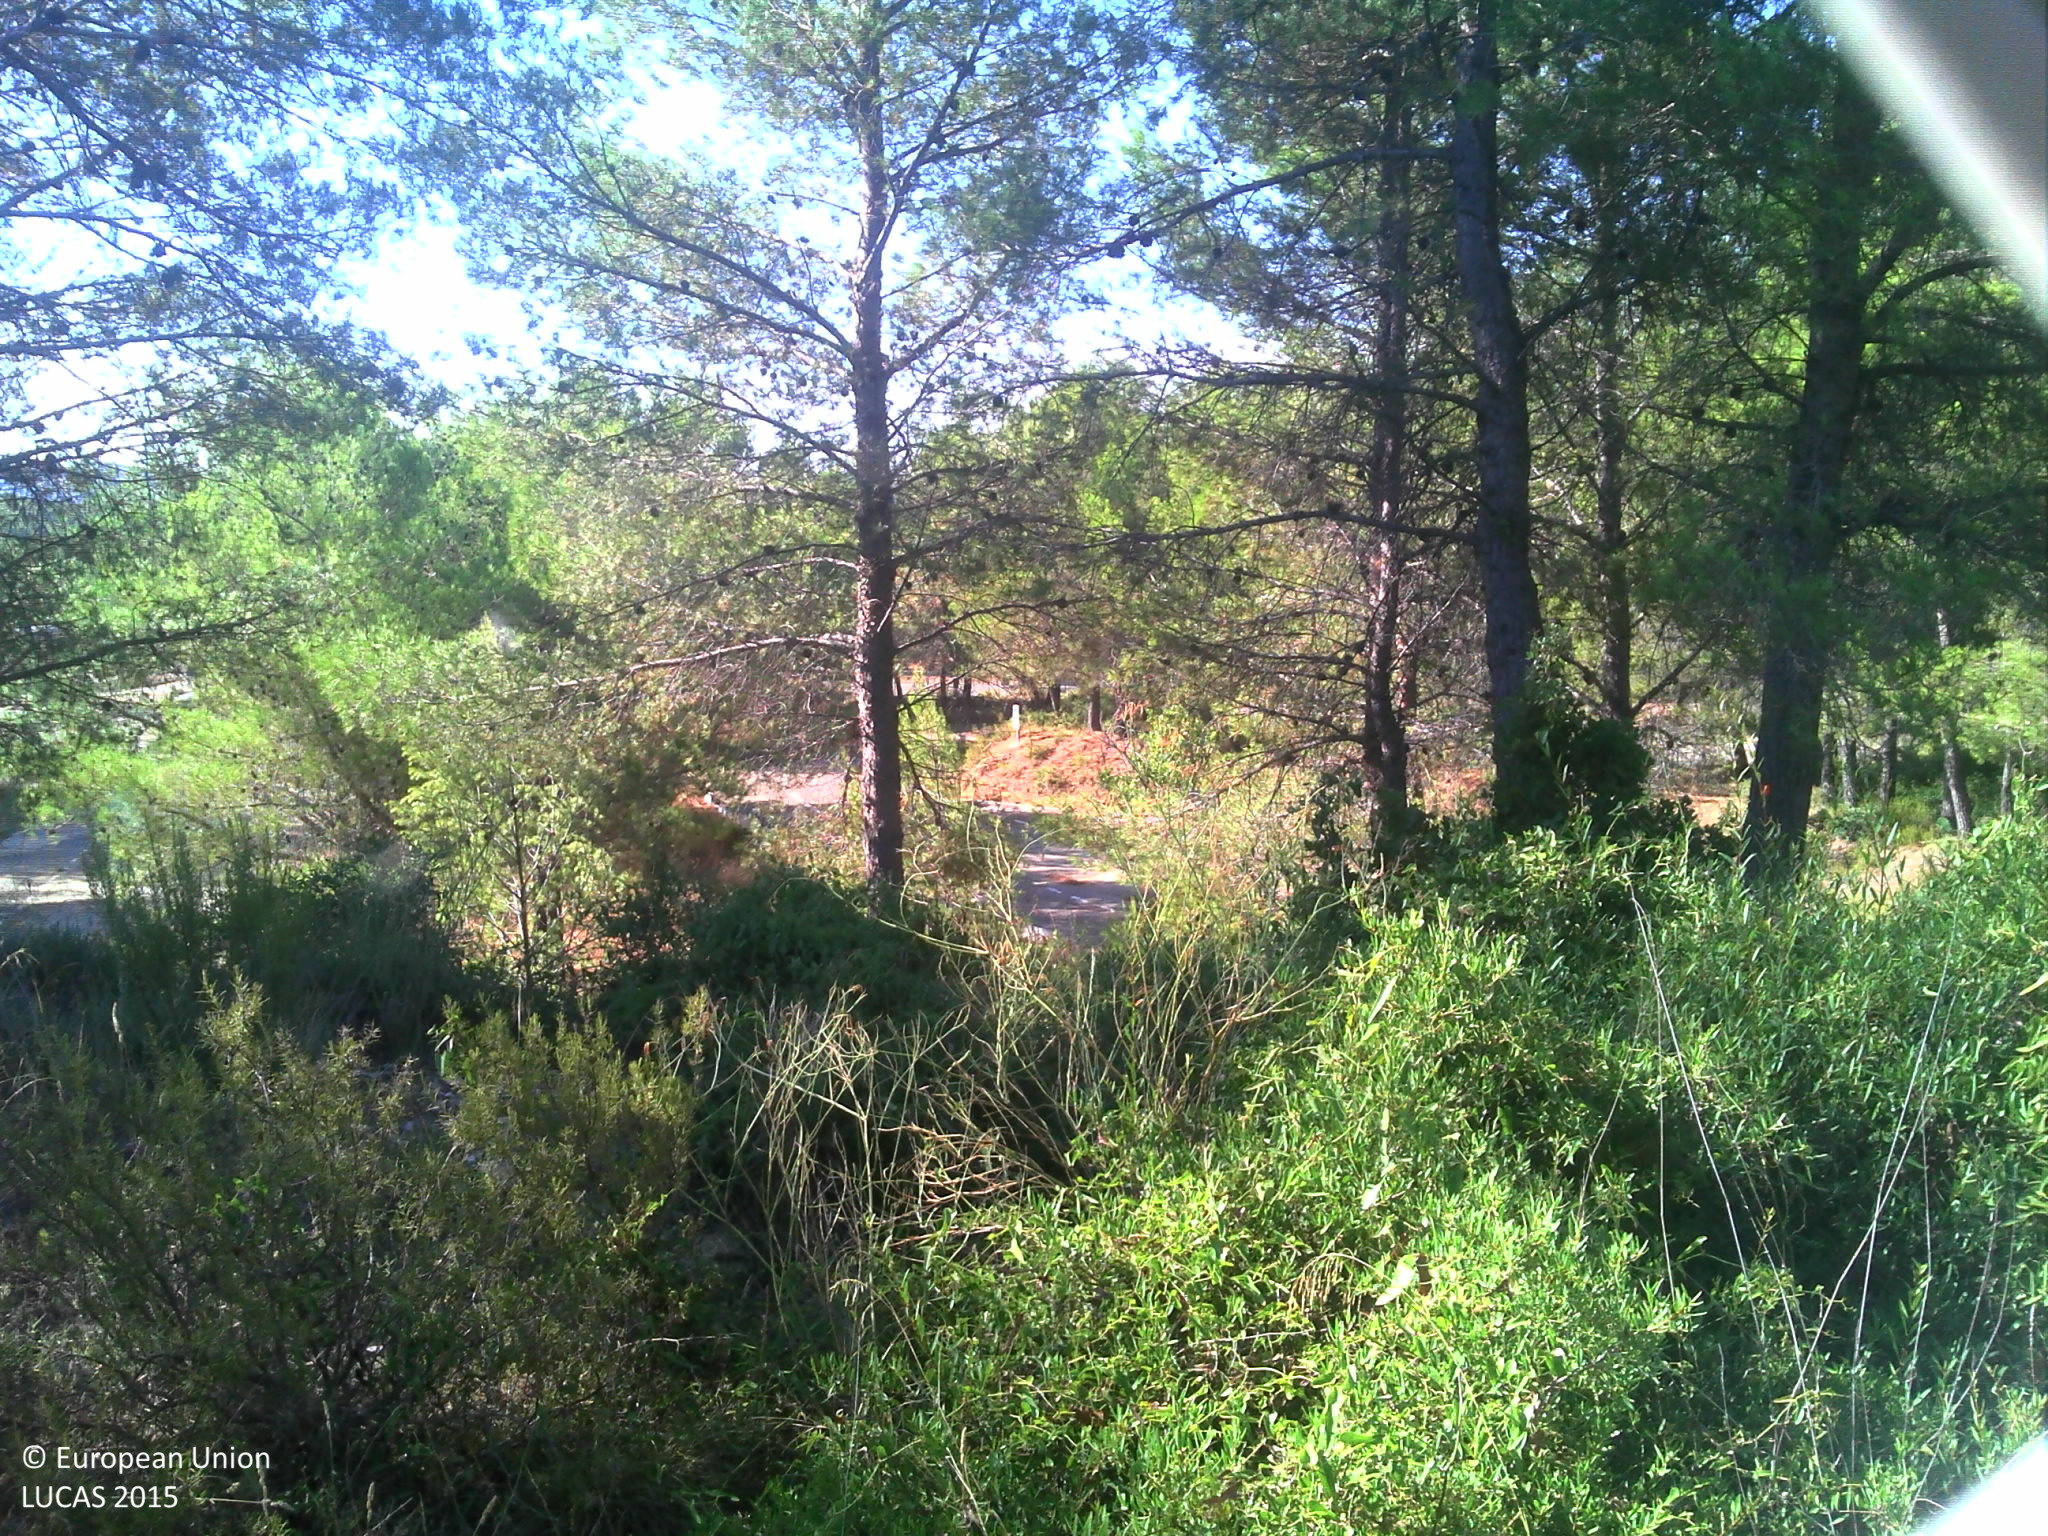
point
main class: Woodland
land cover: Pine dominated coniferous woodland
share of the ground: > 75 %
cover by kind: coniferous forest trees 35 %, herbaceous plants 30 %, consolidated bare surface 25 %, shrubs 10 %
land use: Road transport
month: August
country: FR
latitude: 43.1941
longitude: 5.6666
